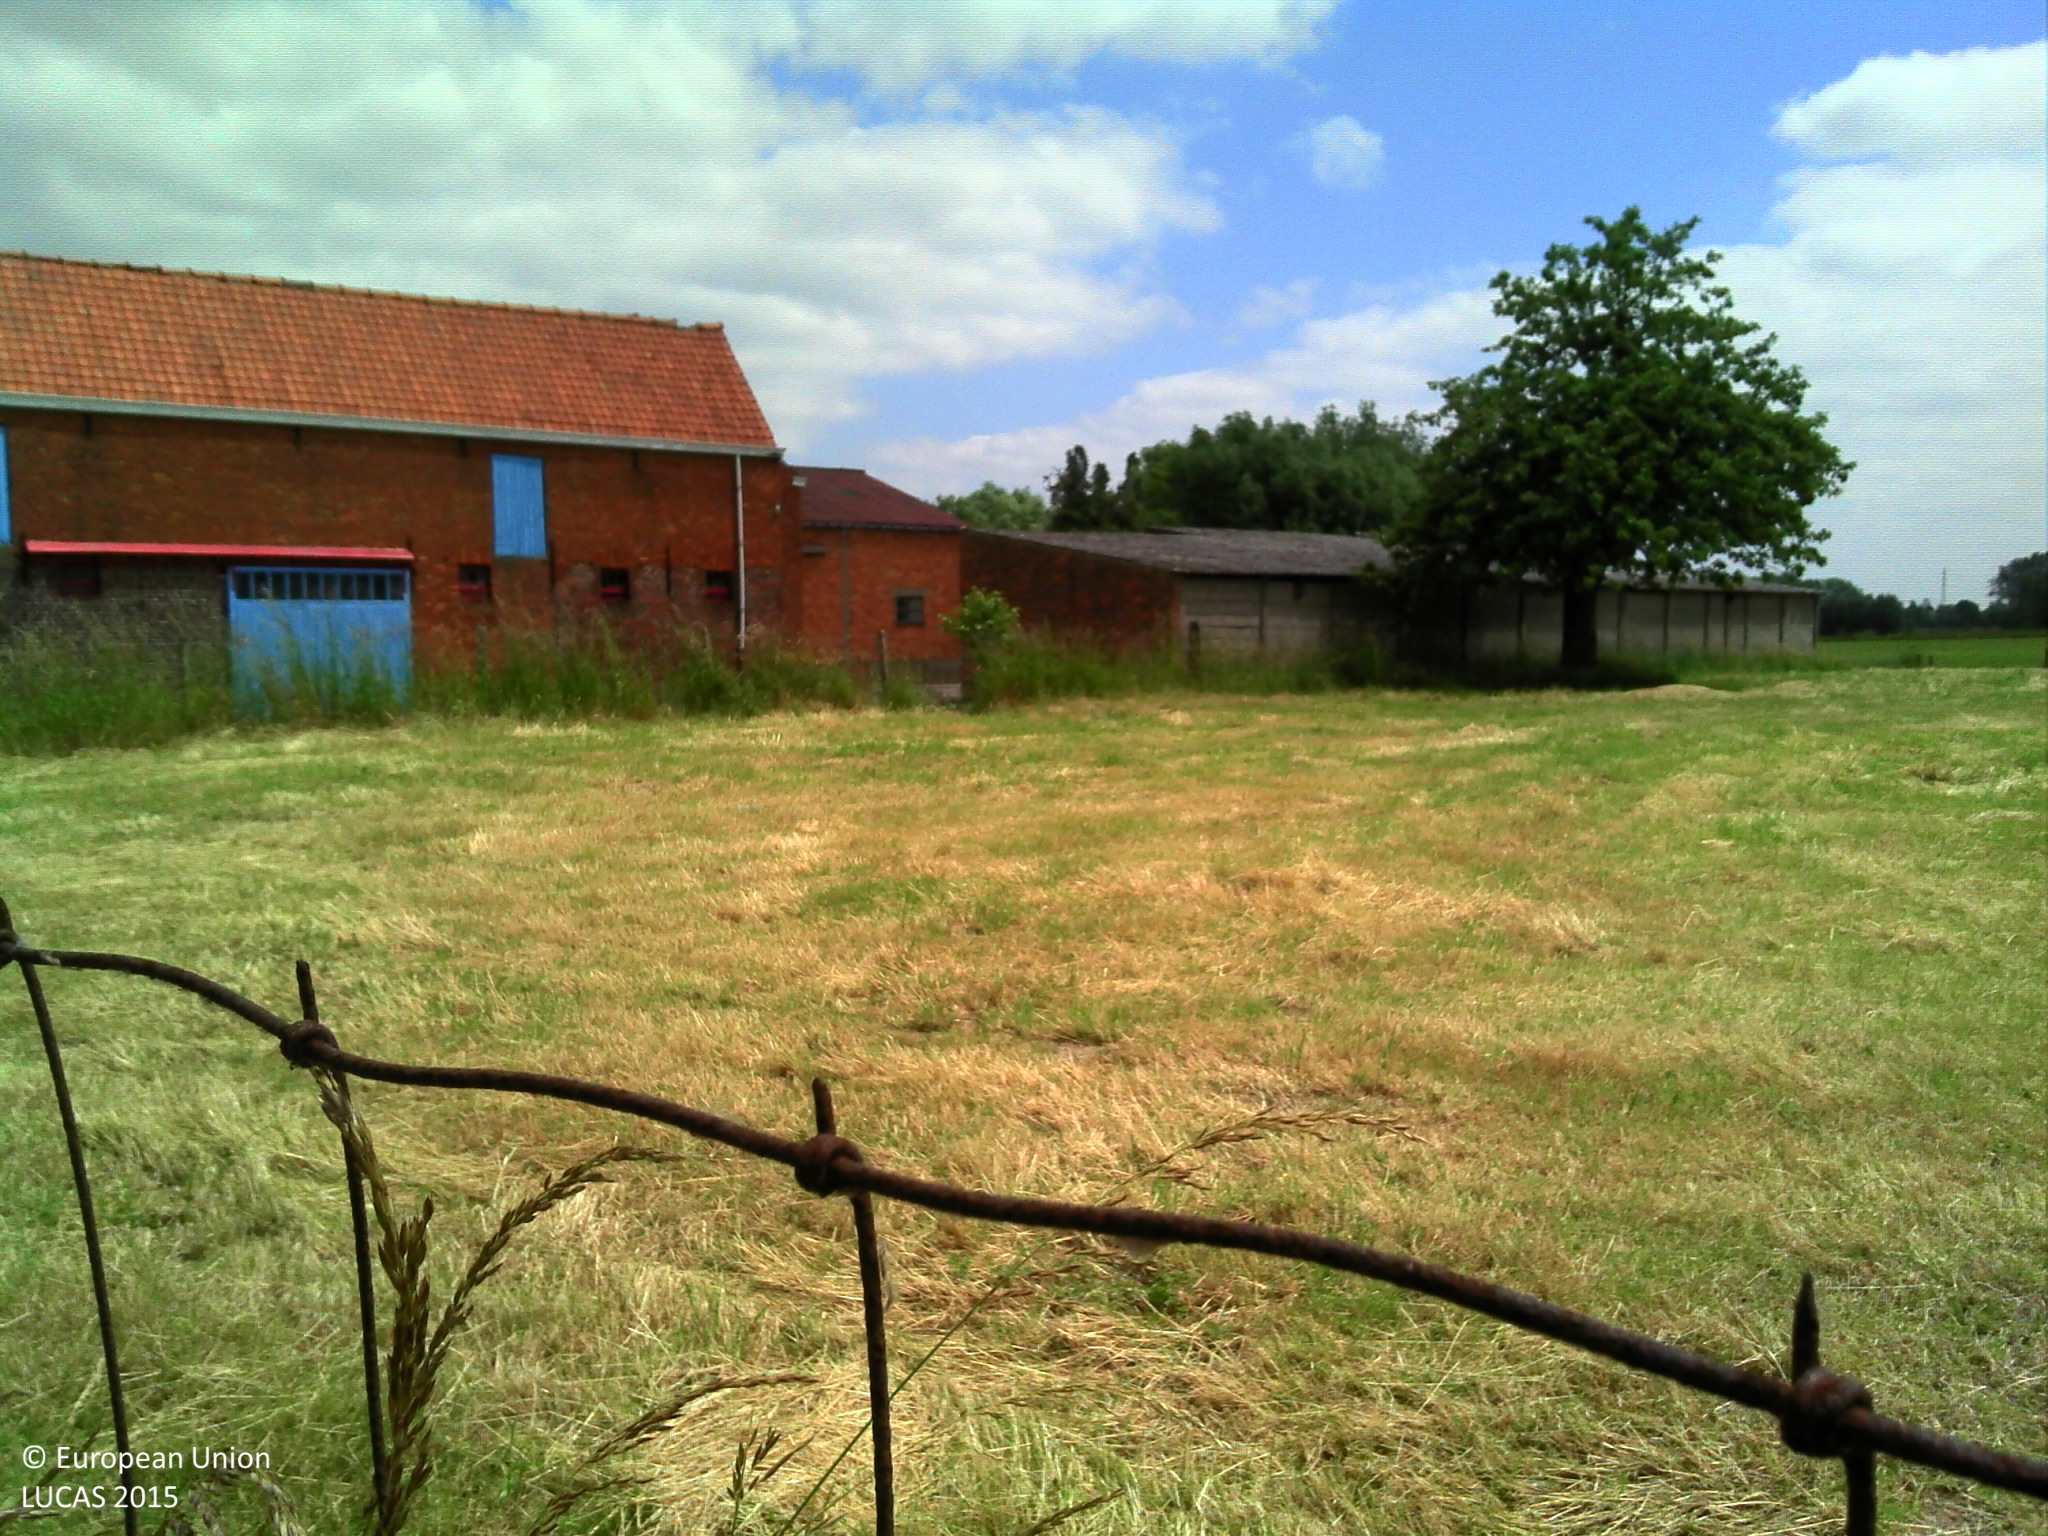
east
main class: Grassland
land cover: Grassland with sparse tree/shrub cover
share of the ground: > 75 %
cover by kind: herbaceous plants 95 %, broadleaved forest trees 5 %
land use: Agriculture (excluding fallow land and kitchen gardens)
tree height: < 5 m
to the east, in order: Grassland with sparse tree/shrub cover; Artificial constructions in urban areas; Grassland with sparse tree/shrub cover; Artificial constructions in urban areas; Grassland without tree/shrub cover; Fences; Tracks; Fences; Grassland without tree/shrub cover; Artificial constructions in urban areas; Maize
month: June
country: BE
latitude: 50.9876
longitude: 4.1110
